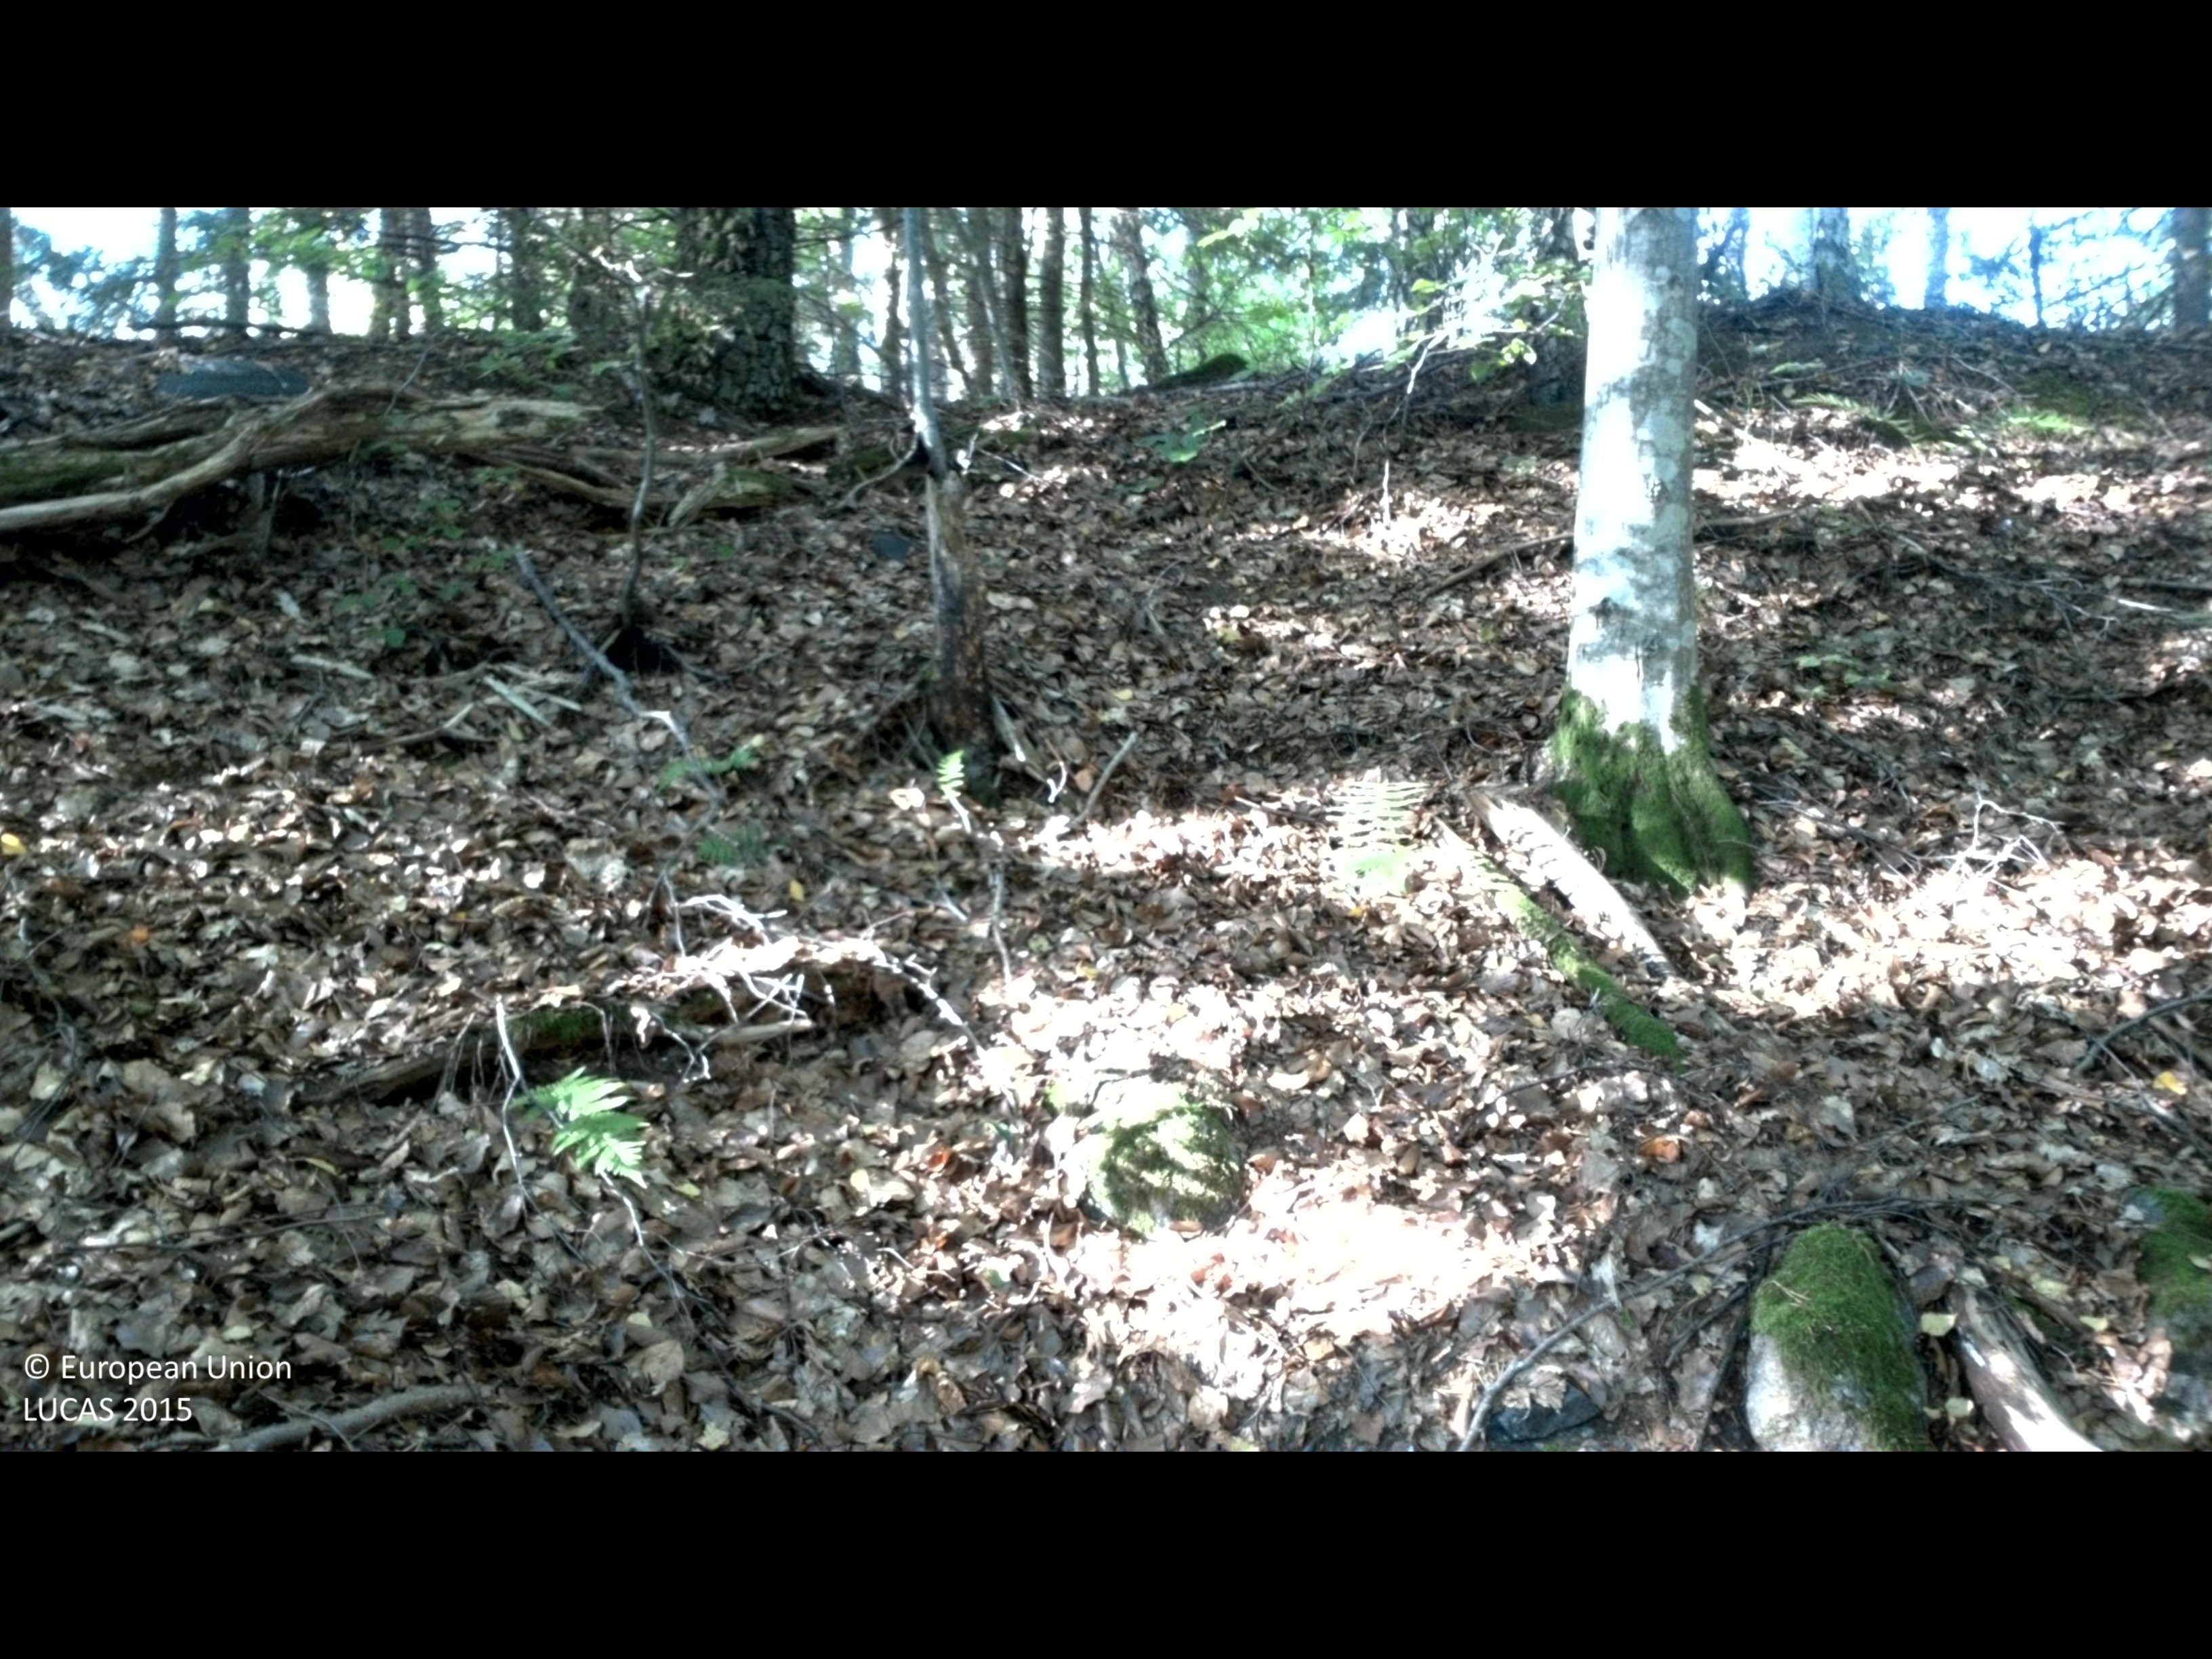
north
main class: Woodland
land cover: Broadleaved woodland
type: beech forest
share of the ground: > 75 %
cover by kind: broadleaved forest trees 80 %
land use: Forestry
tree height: > 5 m
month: September
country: SE
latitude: 56.1720
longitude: 14.2338
